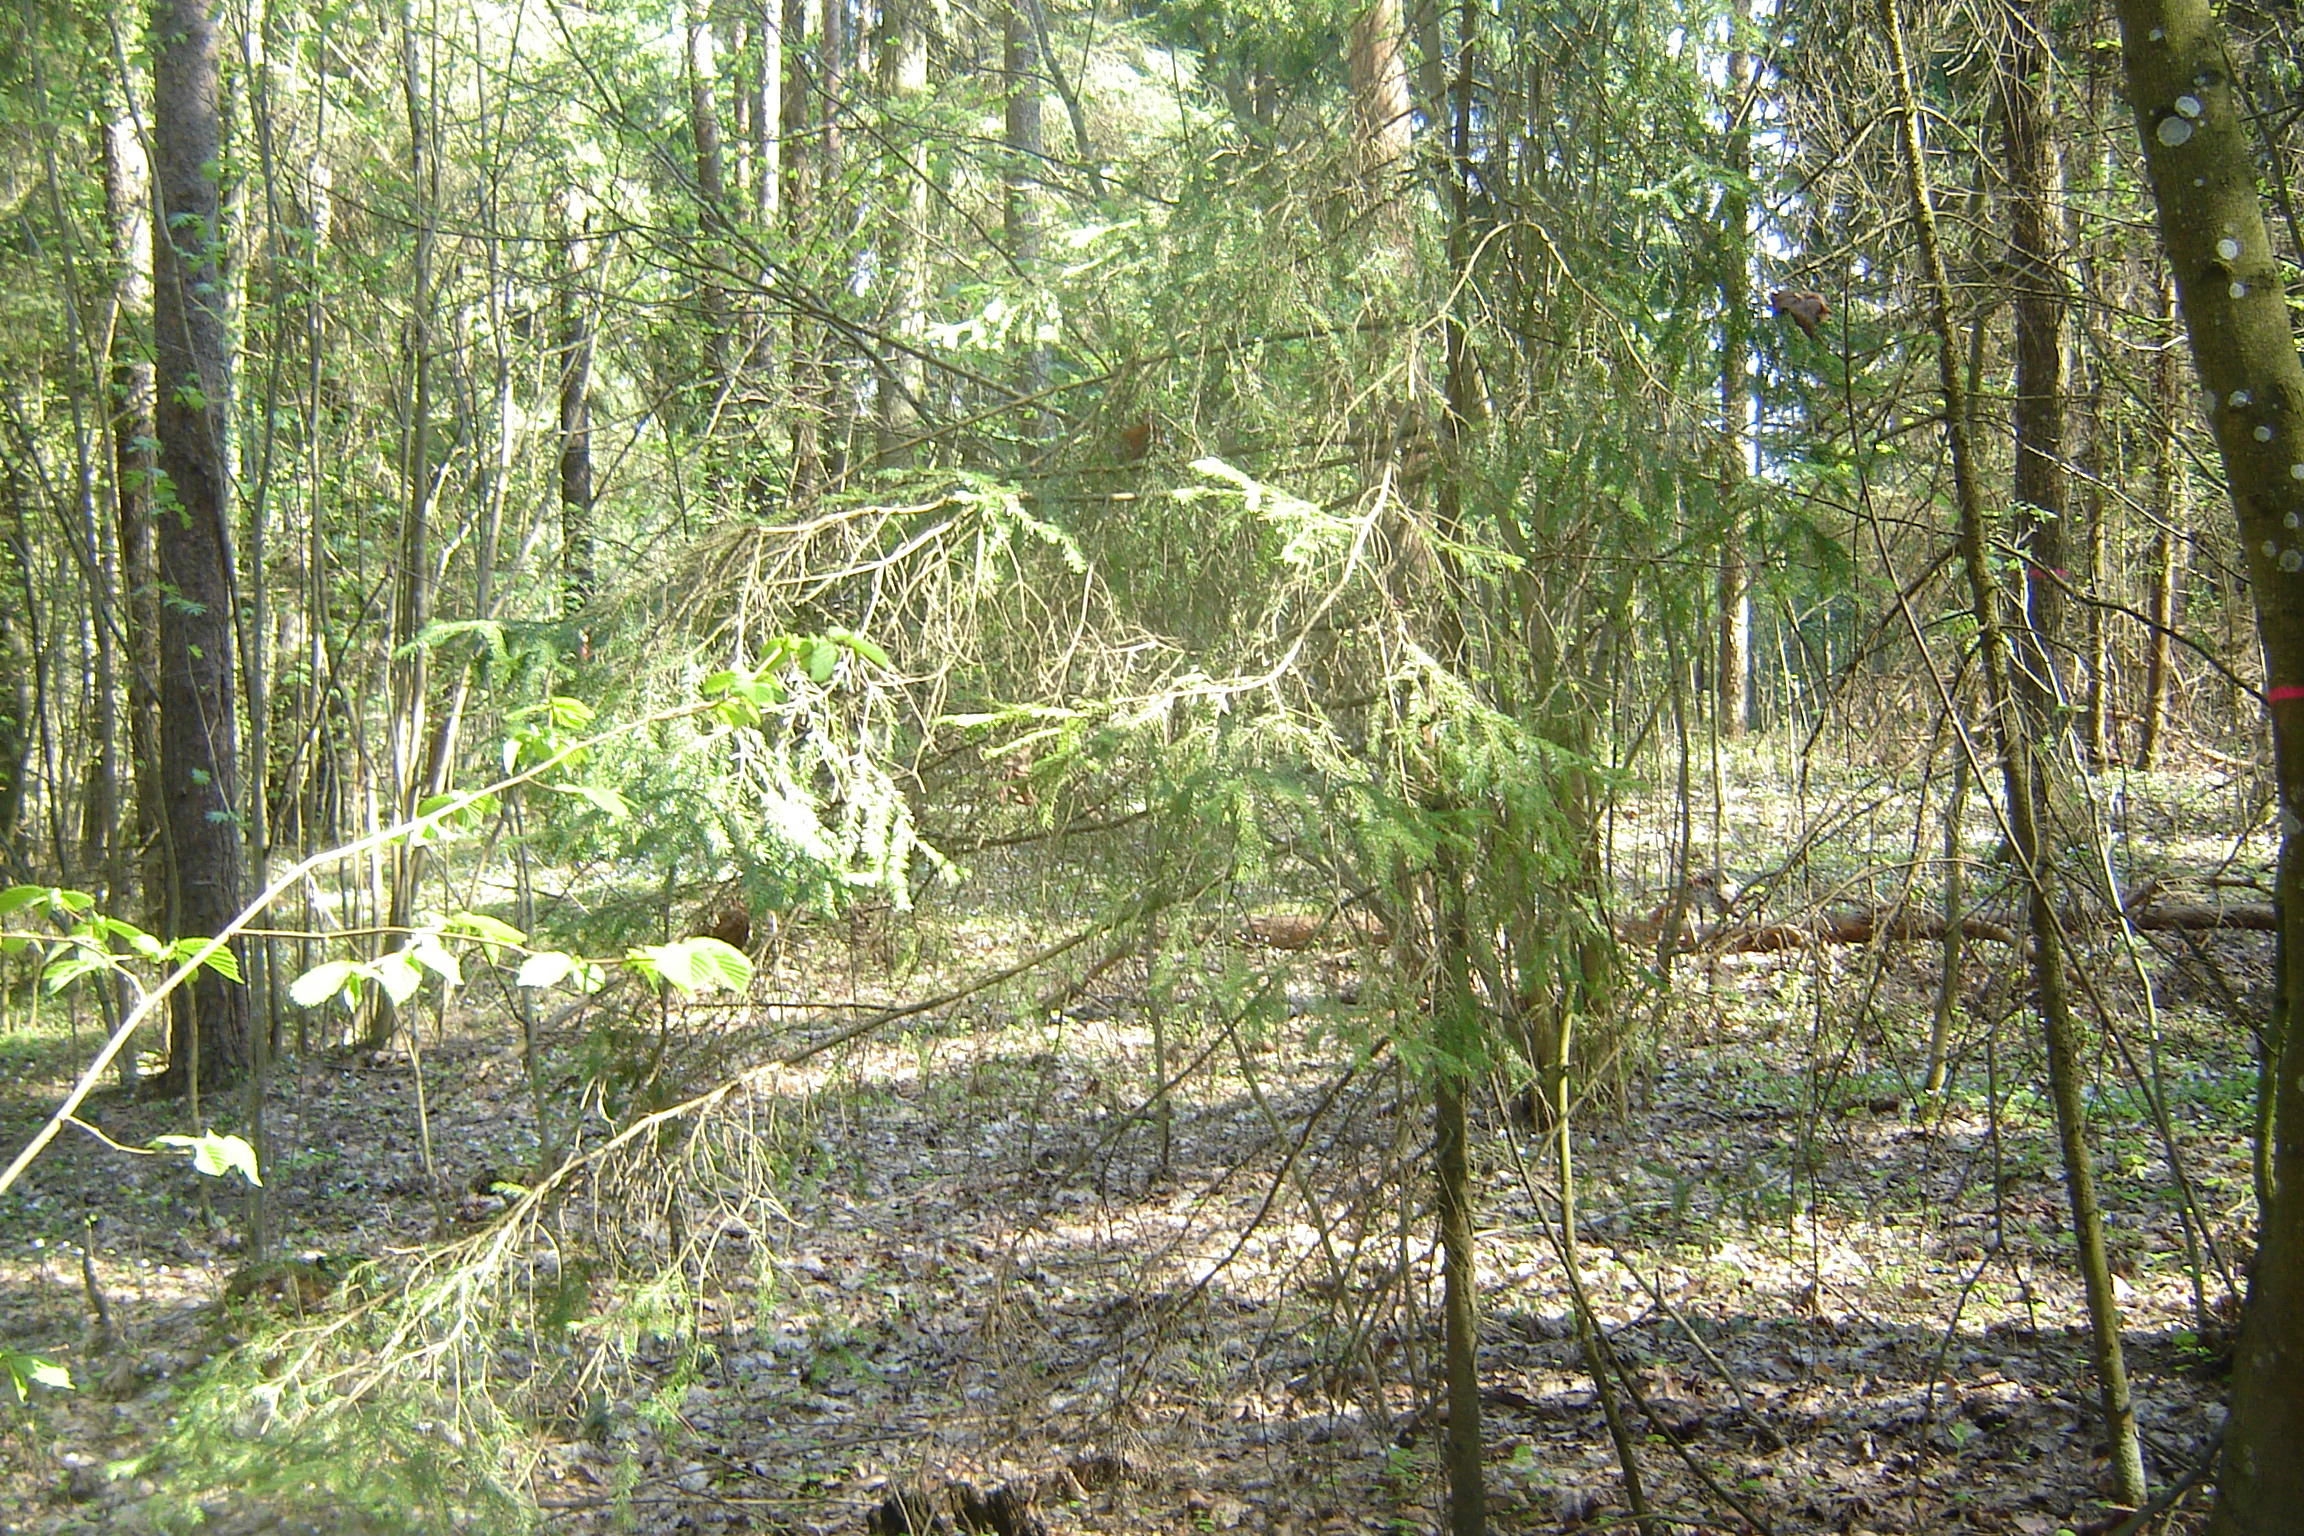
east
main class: Woodland
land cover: Other coniferous woodland
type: hemiboreal forest and nemoral coniferous forest and mixed broadleaved-coniferous forest
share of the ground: > 75 %
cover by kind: coniferous forest trees 100 %
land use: Forestry
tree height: > 5 m
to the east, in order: Other coniferous woodland; Pine dominated mixed woodland
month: May
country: LT
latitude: 56.0195
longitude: 25.7053
